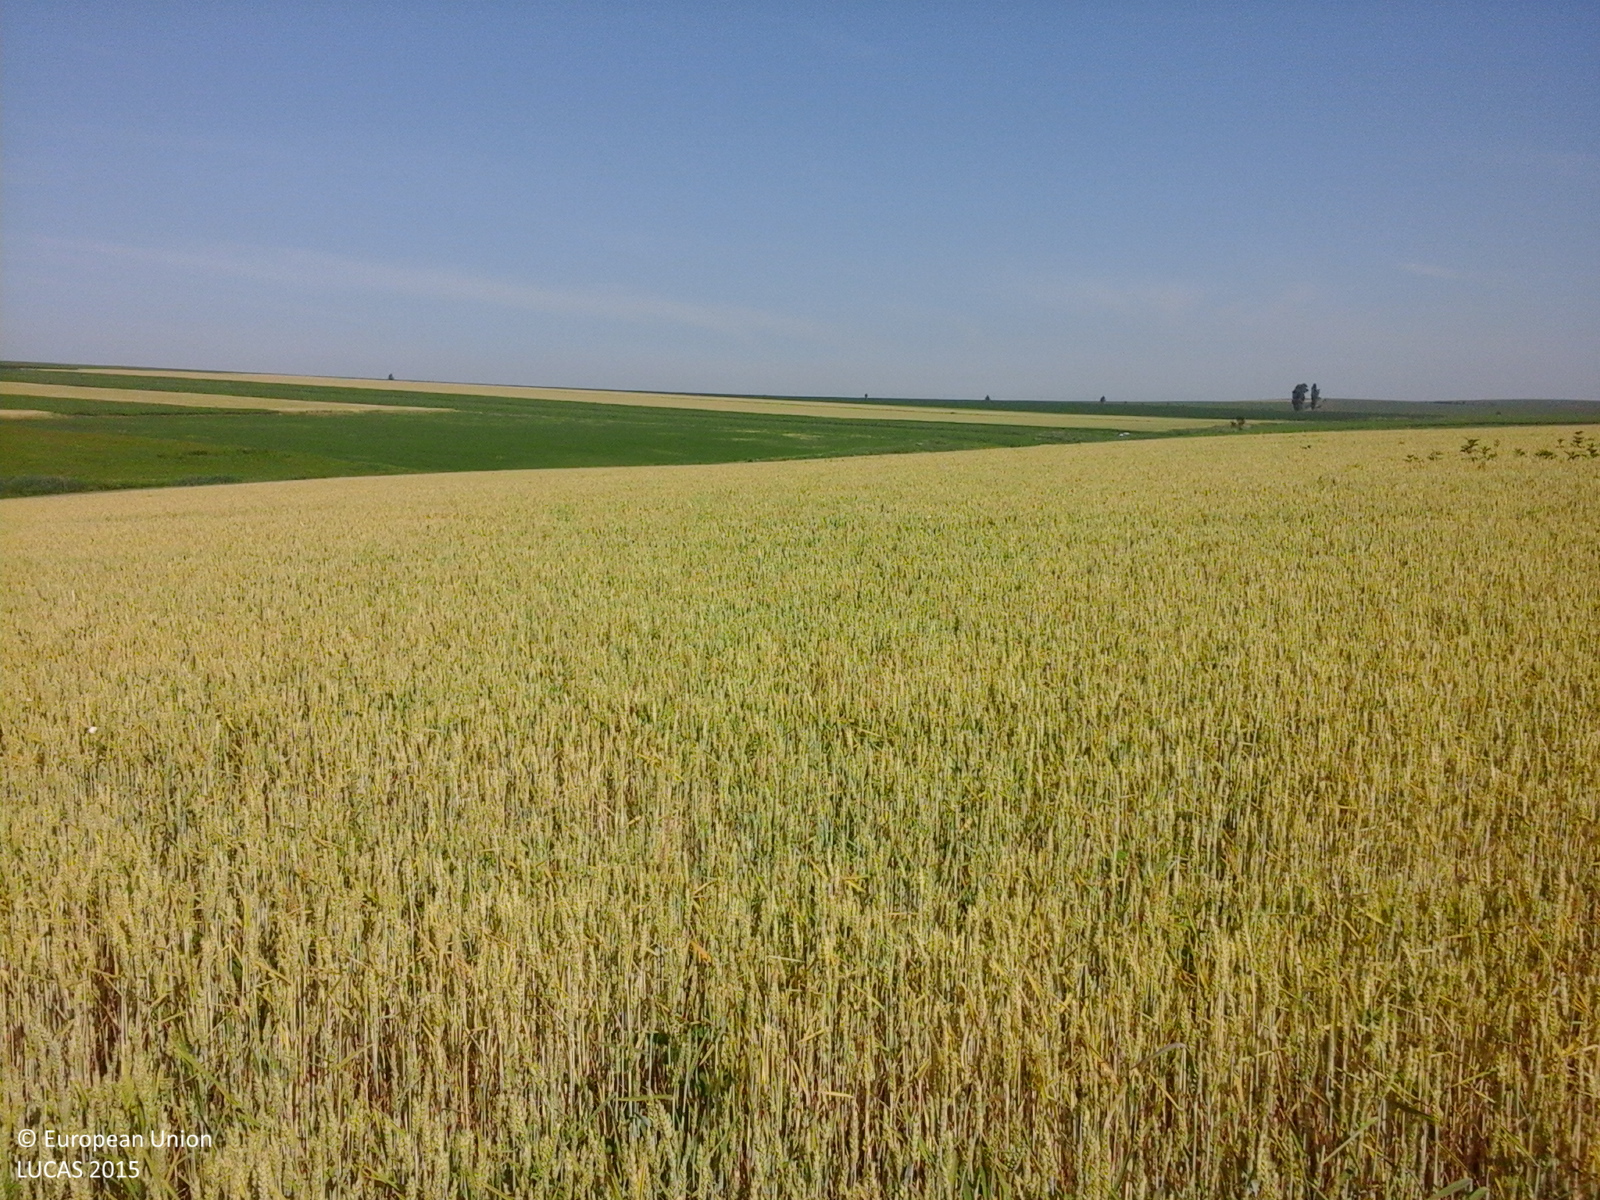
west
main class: Cropland
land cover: Common wheat
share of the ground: > 75 %
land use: Agriculture (excluding fallow land and kitchen gardens)
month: June
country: RO
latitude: 47.6804
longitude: 27.1185
